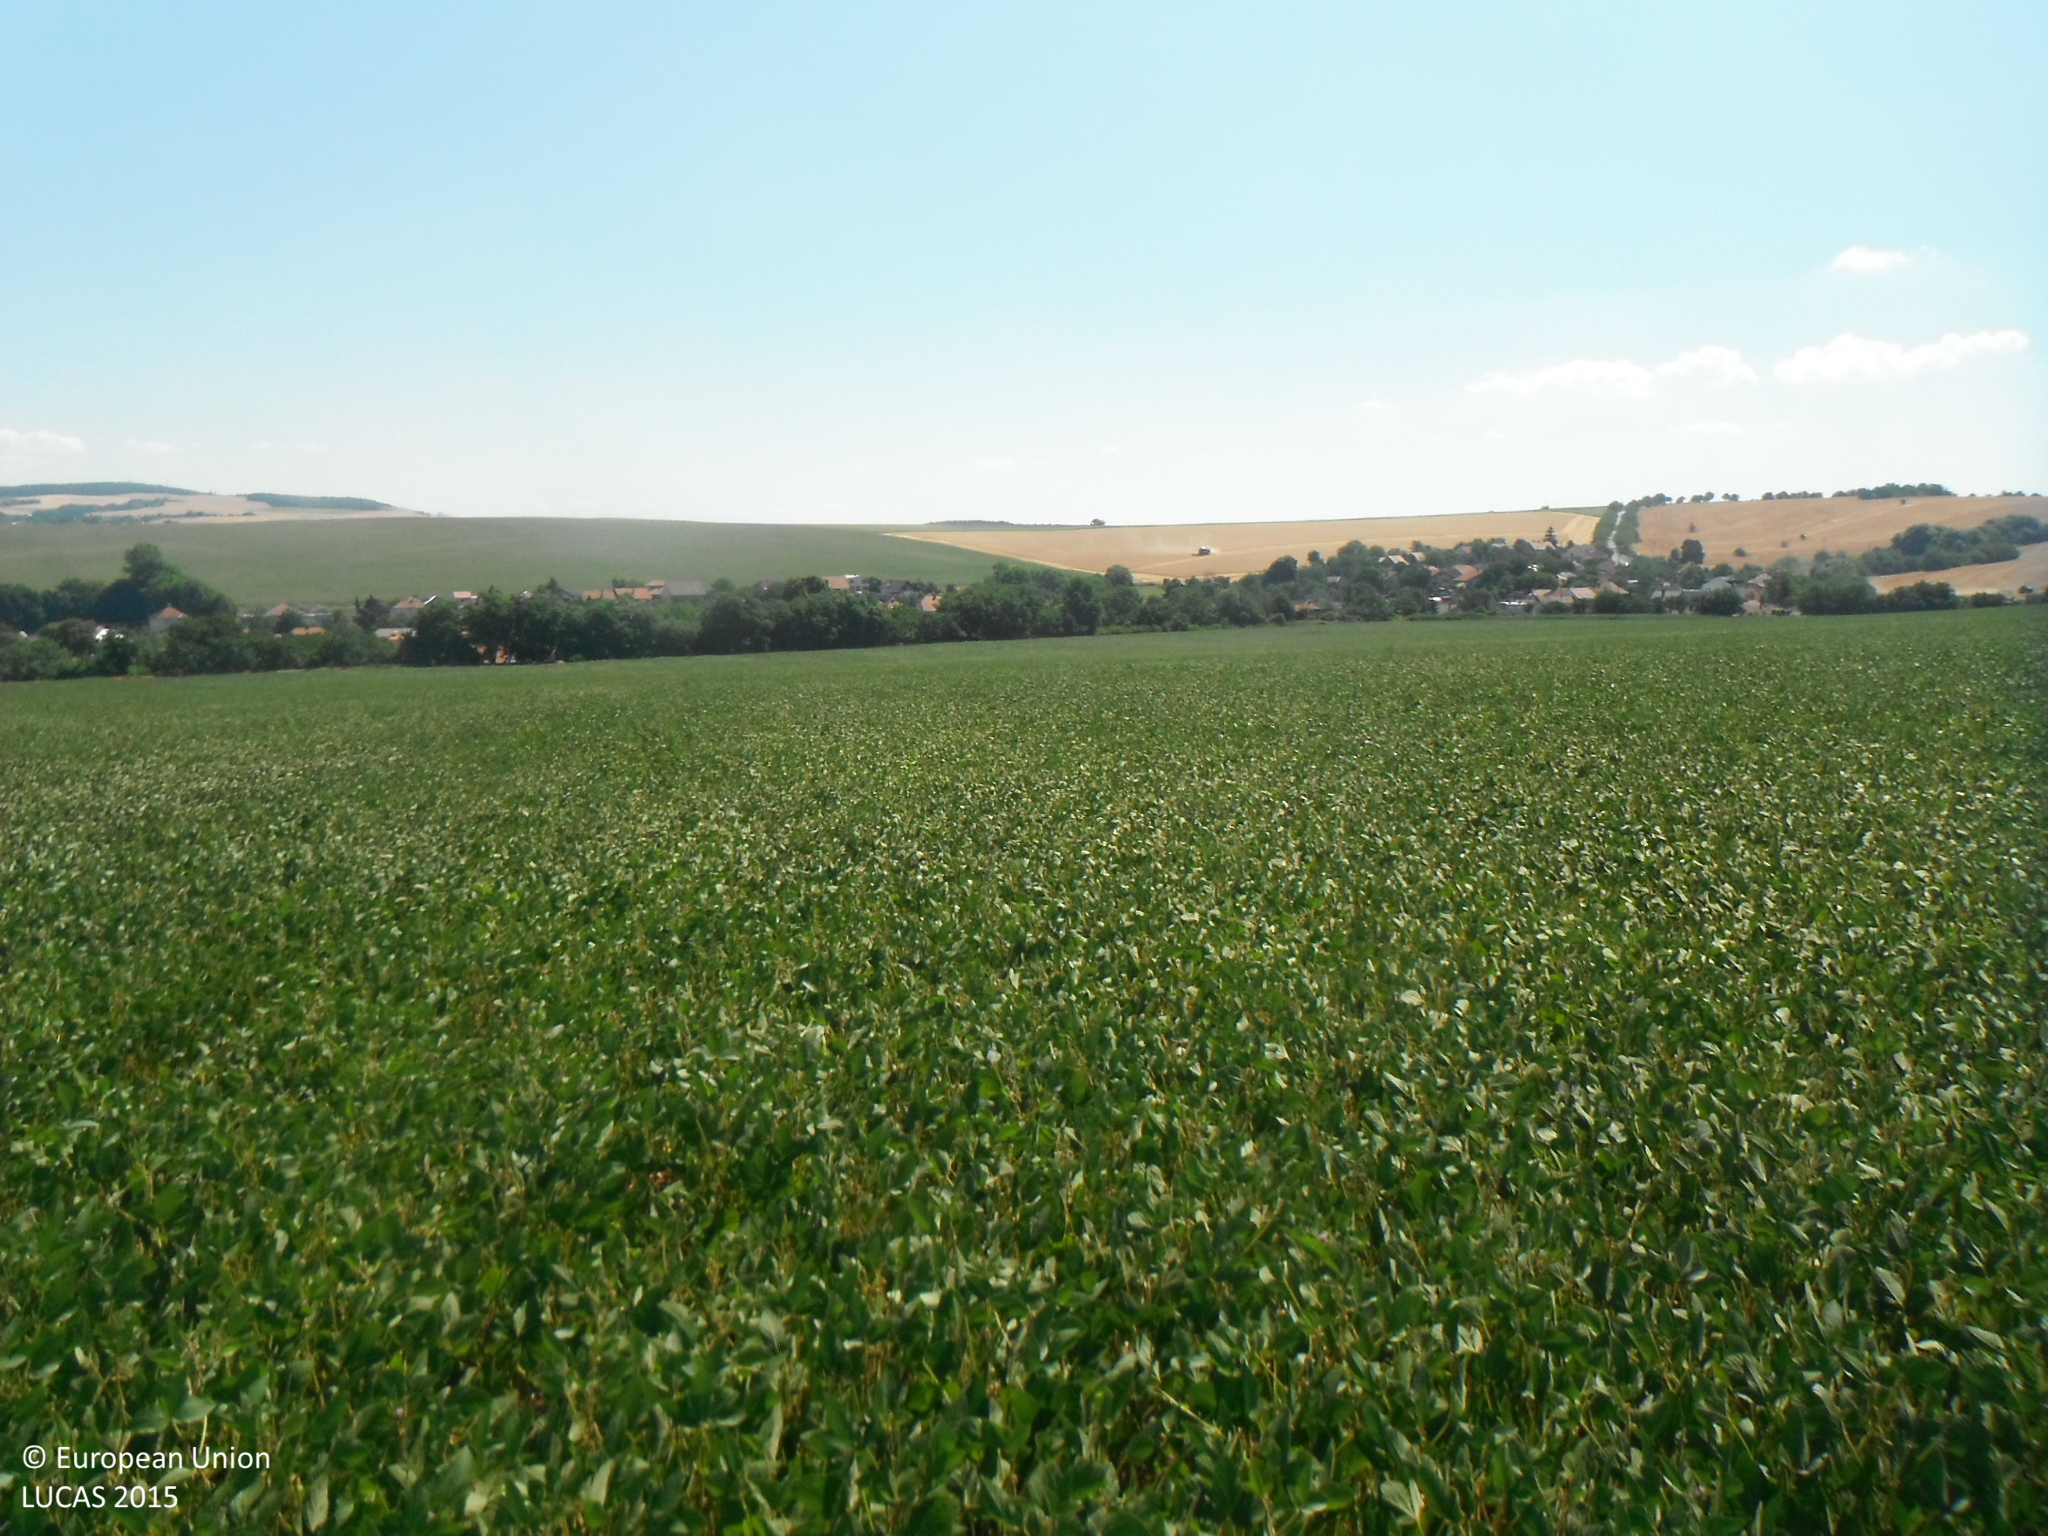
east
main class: Cropland
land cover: Soya
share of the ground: > 75 %
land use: Agriculture (excluding fallow land and kitchen gardens)
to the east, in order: Soya
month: July
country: SK
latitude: 48.7124
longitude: 17.1716
